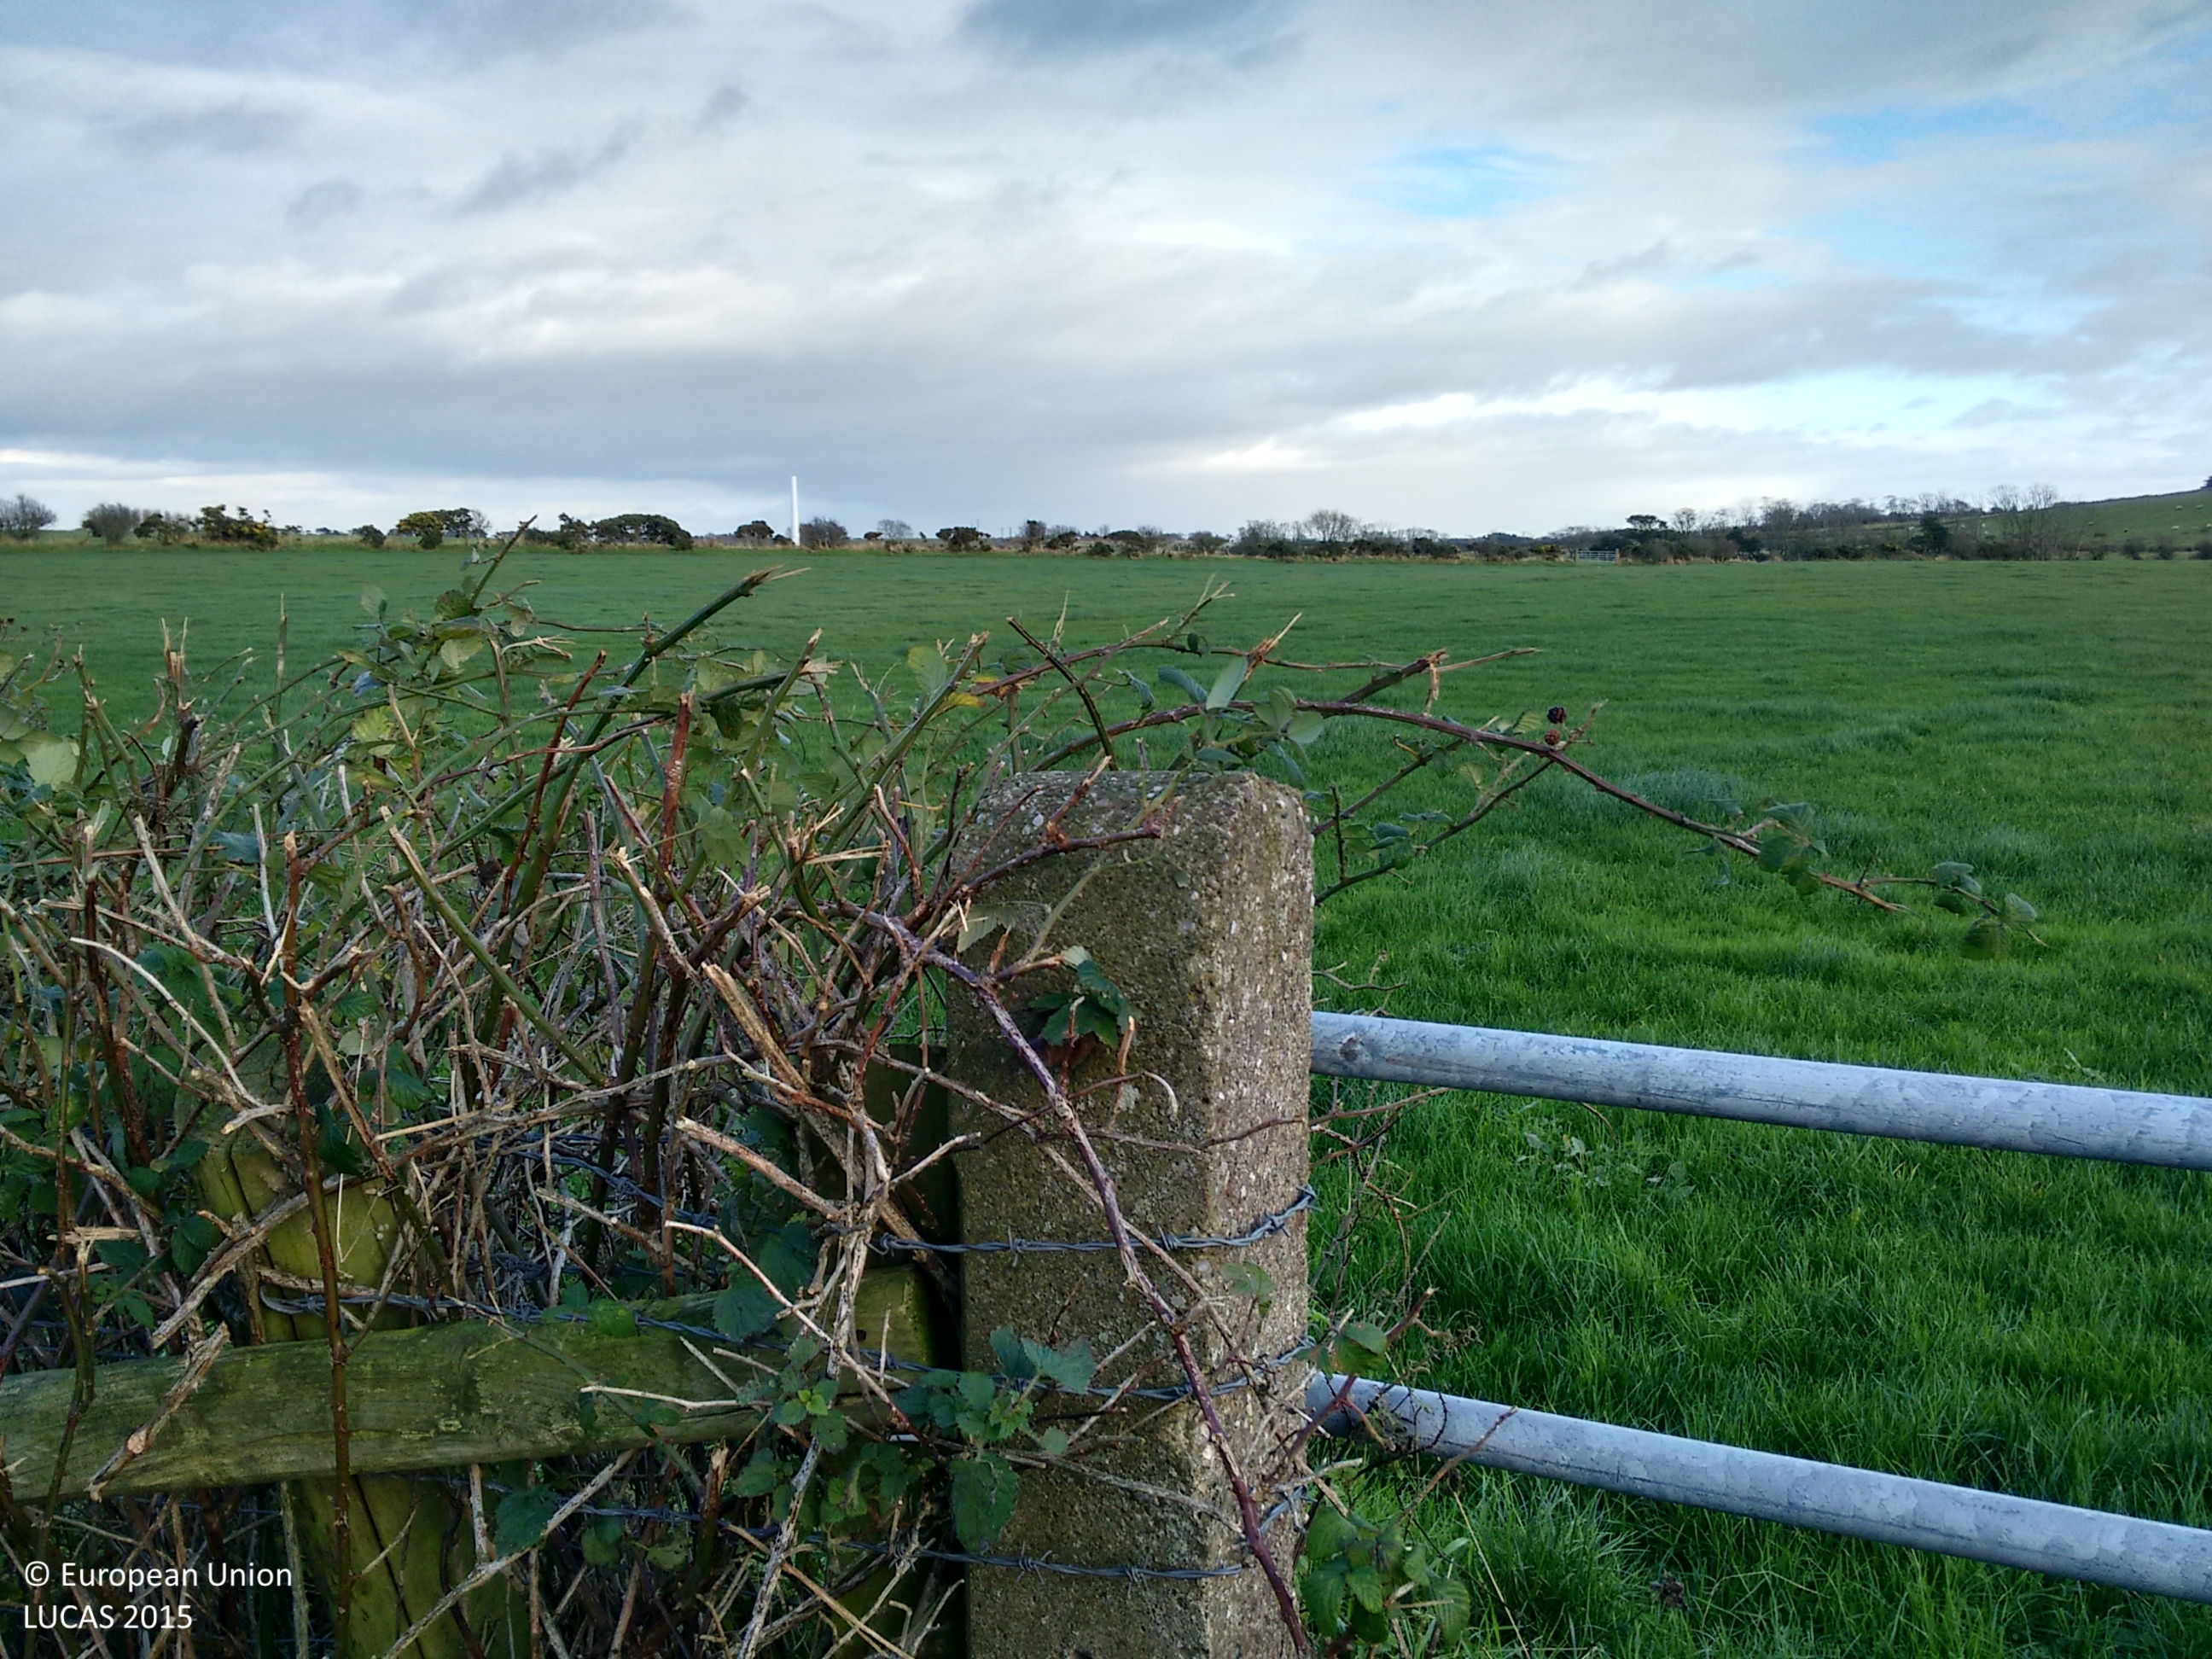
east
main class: Grassland
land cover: Grassland without tree/shrub cover
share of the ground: > 75 %
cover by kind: herbaceous plants 100 %
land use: Agriculture (excluding fallow land and kitchen gardens)
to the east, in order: Grassland without tree/shrub cover; Grass margins; Abandoned hedges; Ditches and canals; Grassland without tree/shrub cover
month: November
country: GB
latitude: 54.5220
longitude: -5.4998
